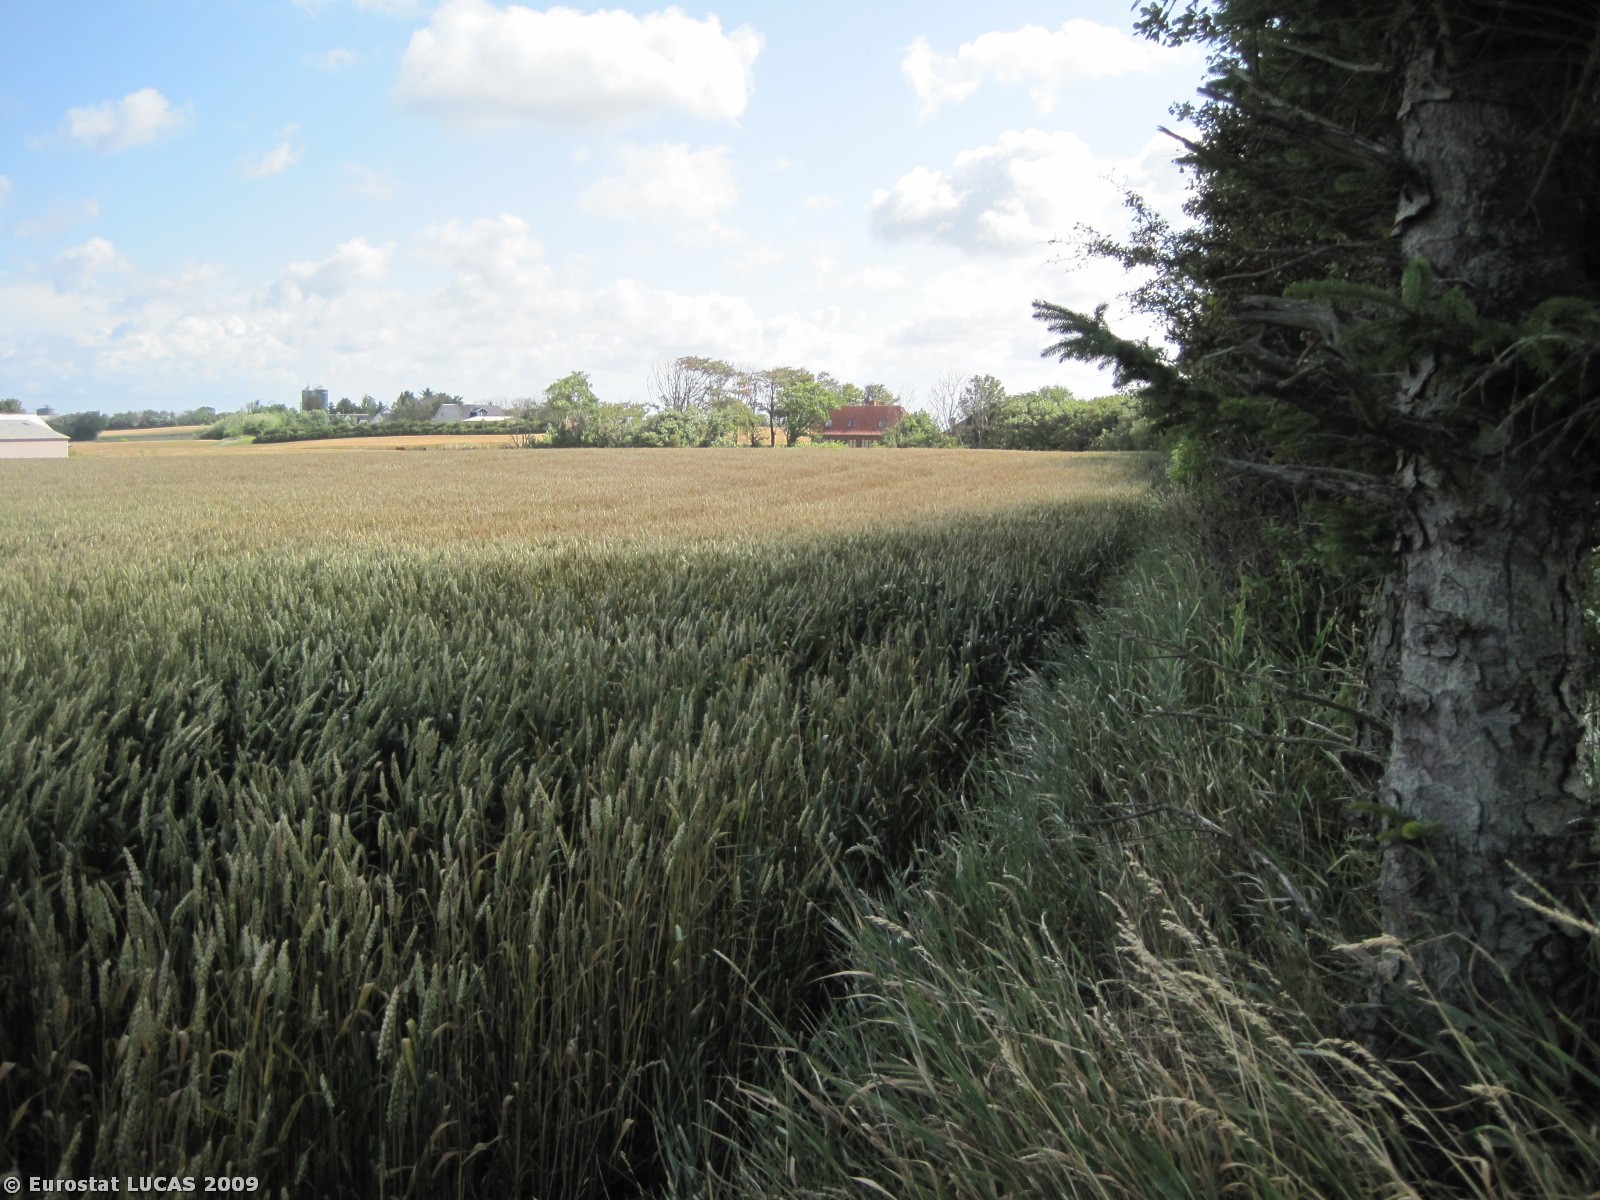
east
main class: Cropland
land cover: Common wheat
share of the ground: > 75 %
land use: Agriculture (excluding fallow land and kitchen gardens)
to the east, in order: Common wheat
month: July
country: DK
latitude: 56.7002
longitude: 8.4832
